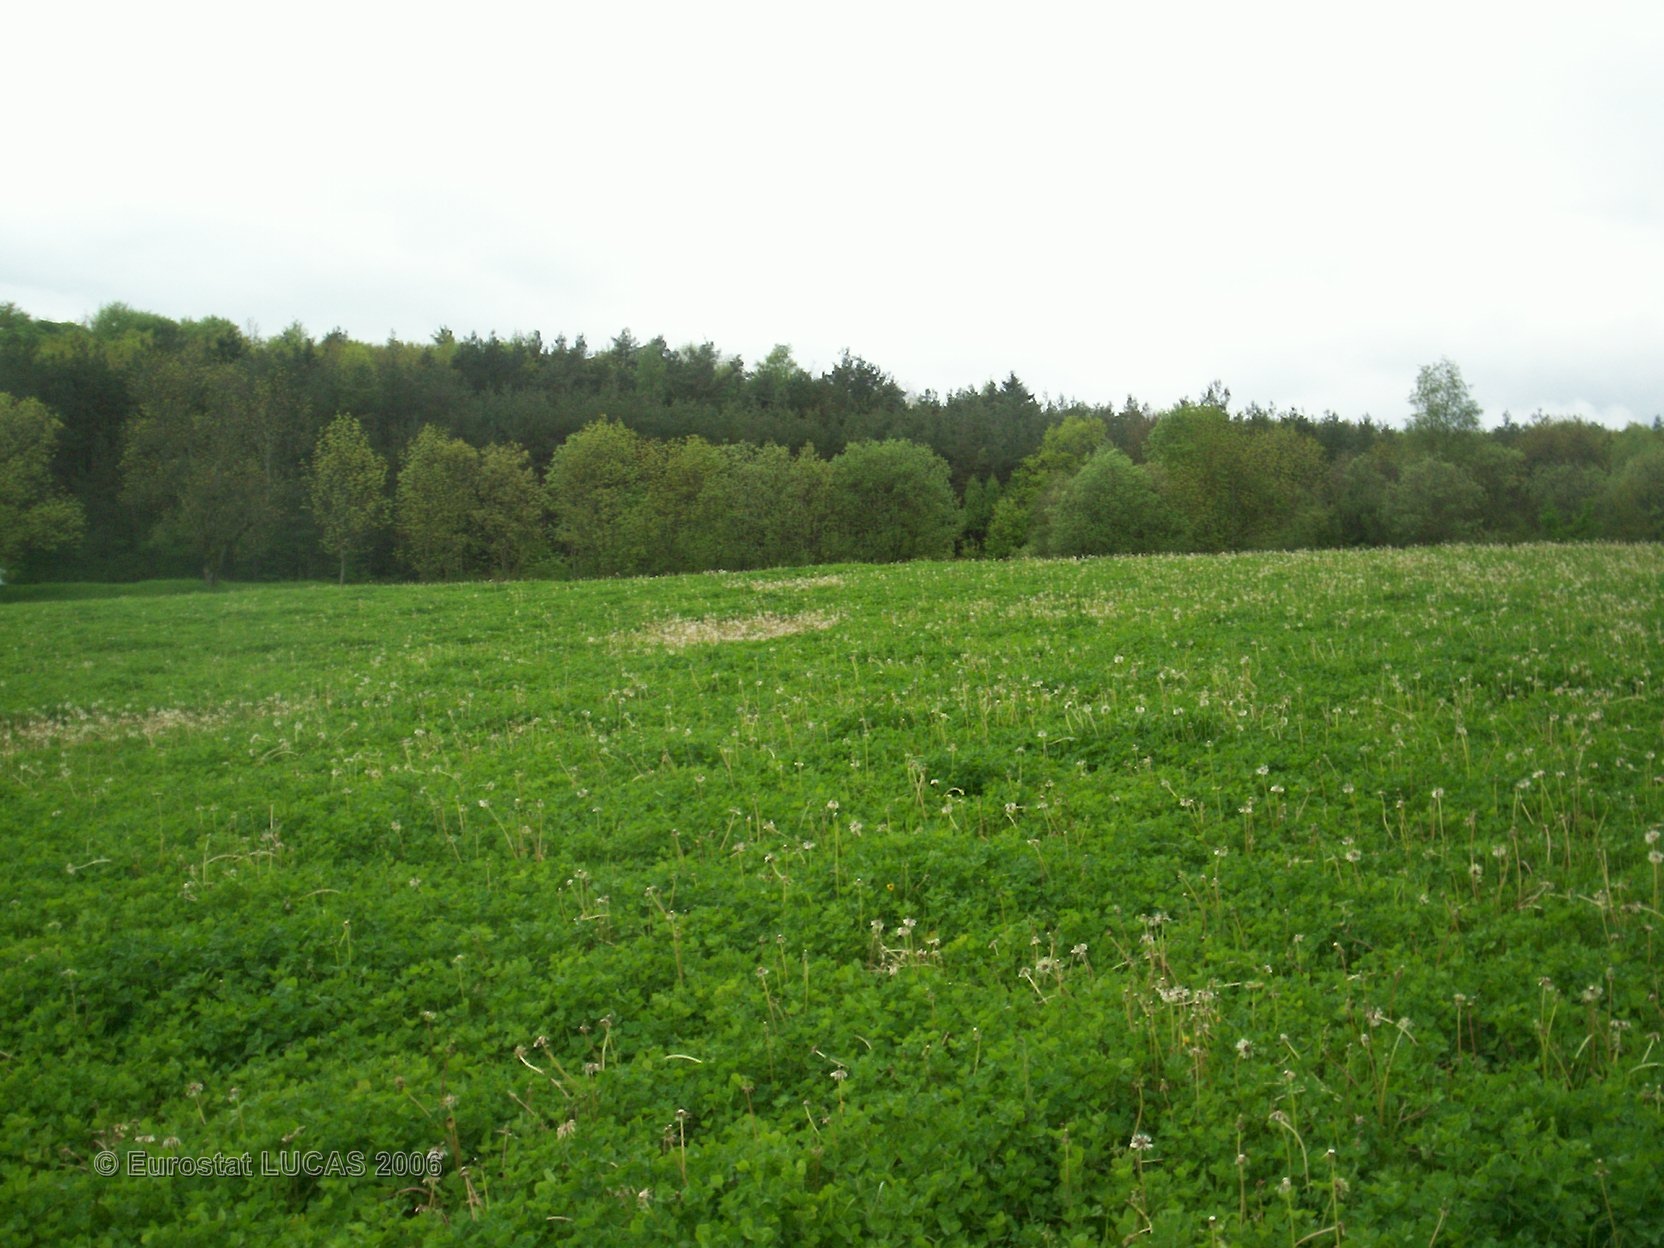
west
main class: Cropland
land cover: Clovers
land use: Agriculture (excluding fallow land and kitchen gardens)
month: May
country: FR
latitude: 47.7304
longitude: 4.5988
